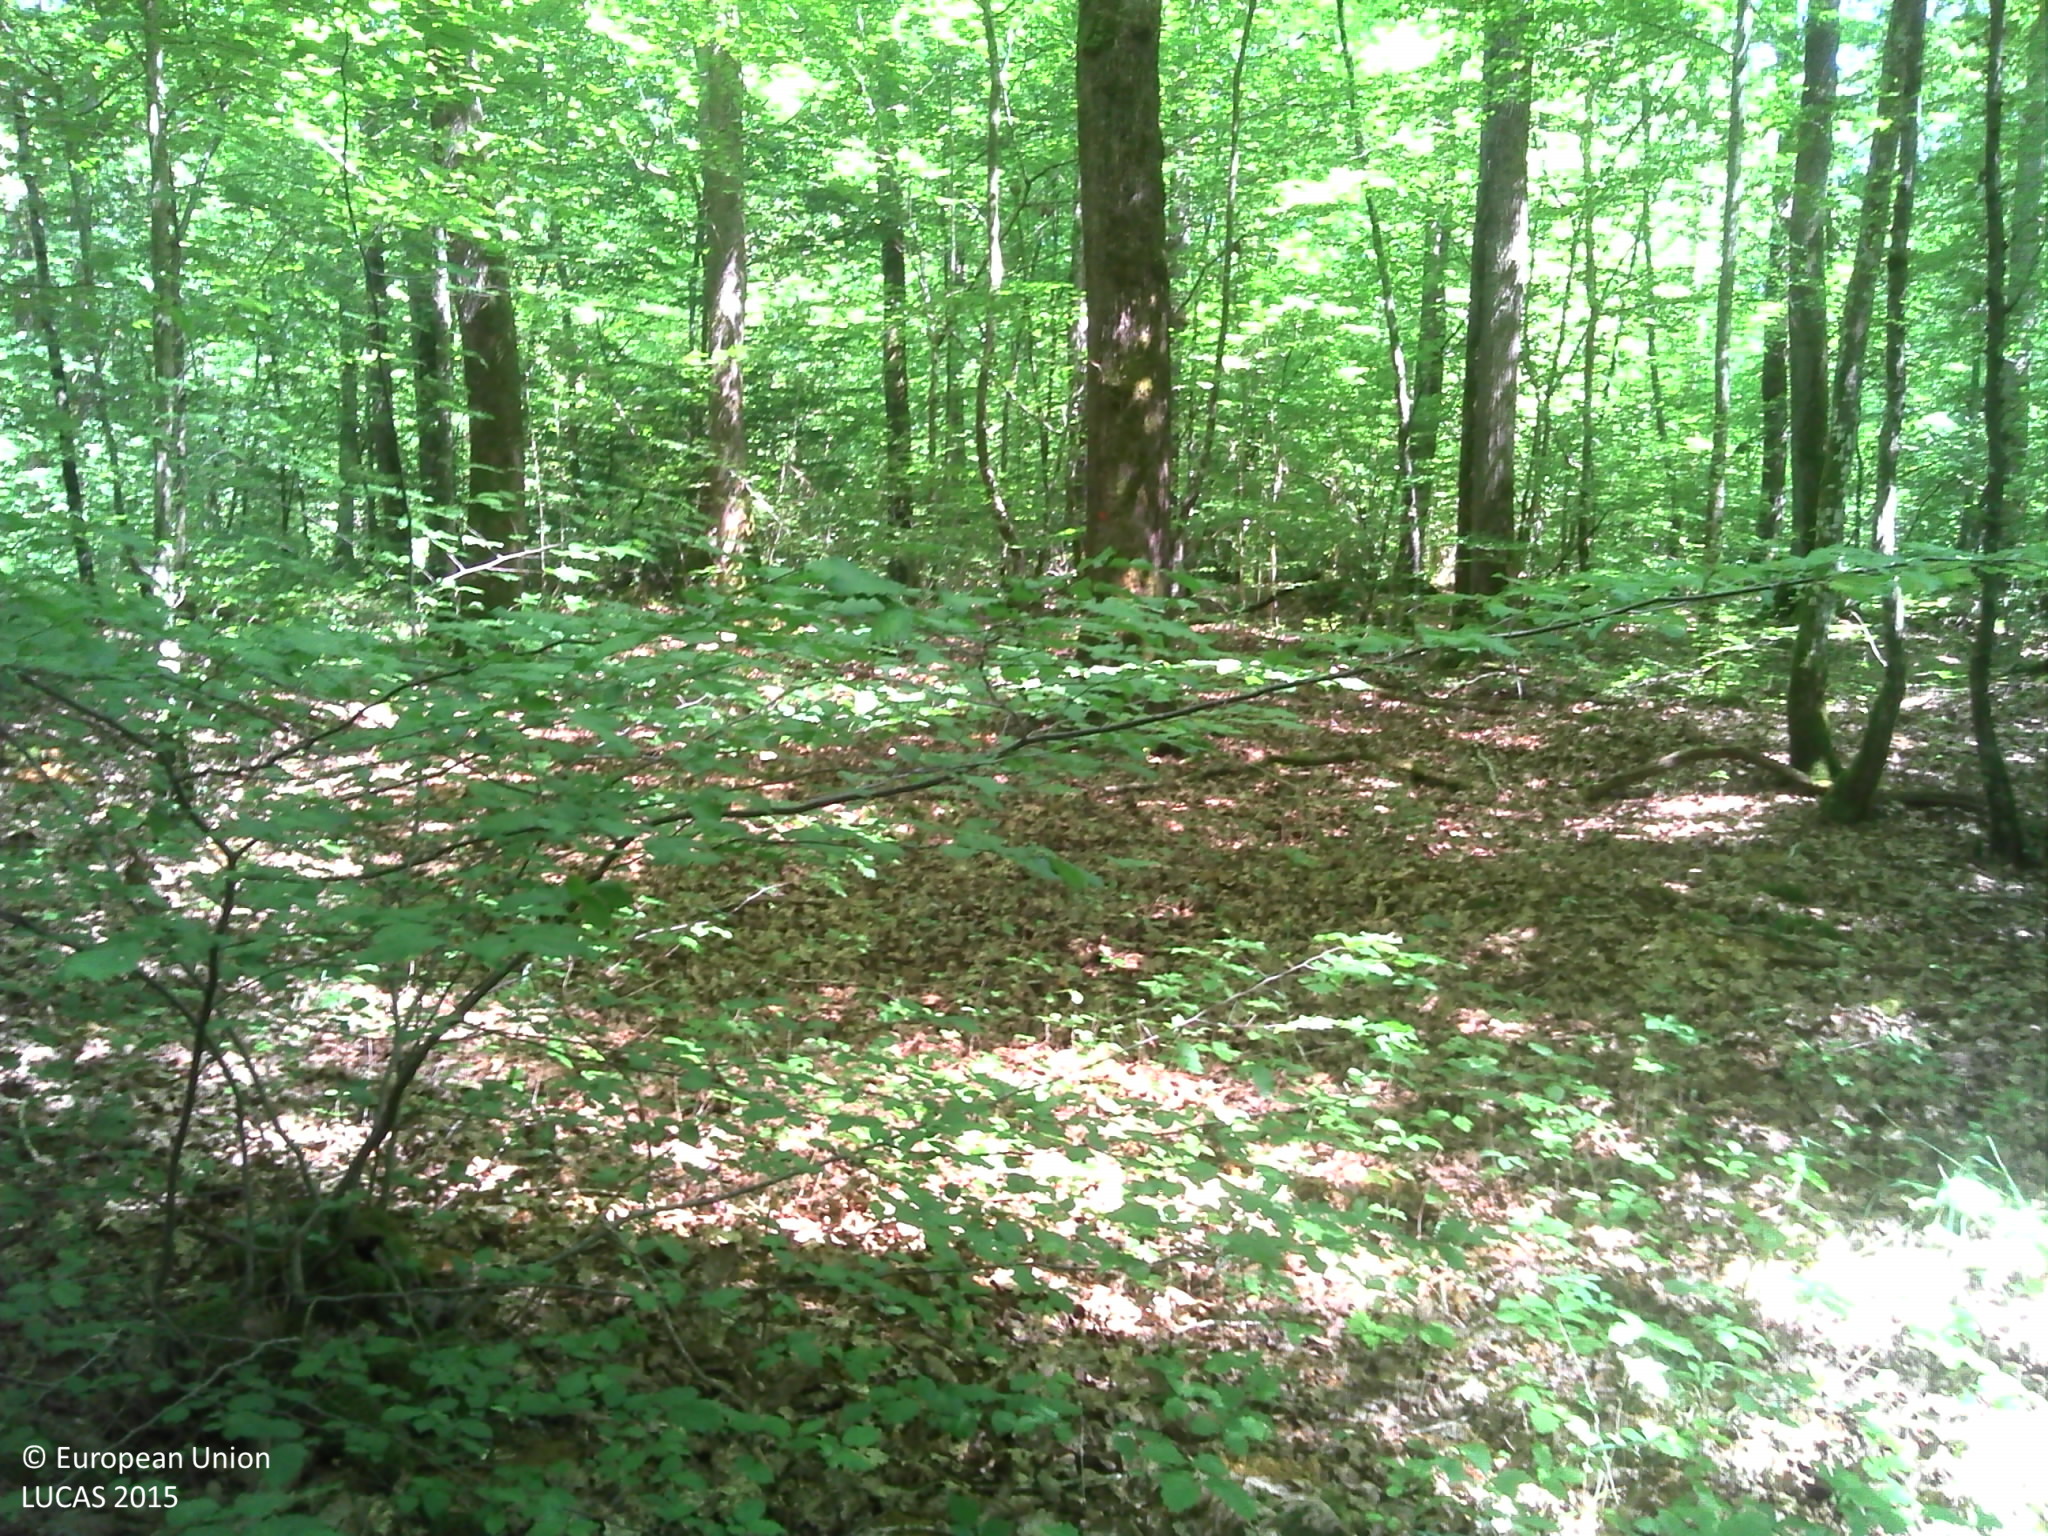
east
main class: Woodland
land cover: Broadleaved woodland
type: mesophytic deciduous forest
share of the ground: > 75 %
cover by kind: broadleaved forest trees 90 %, herbaceous plants 5 %, lichens and mosses 5 %
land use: Forestry
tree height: > 5 m
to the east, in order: Broadleaved woodland
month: June
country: FR
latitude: 47.4772
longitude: 3.5874
